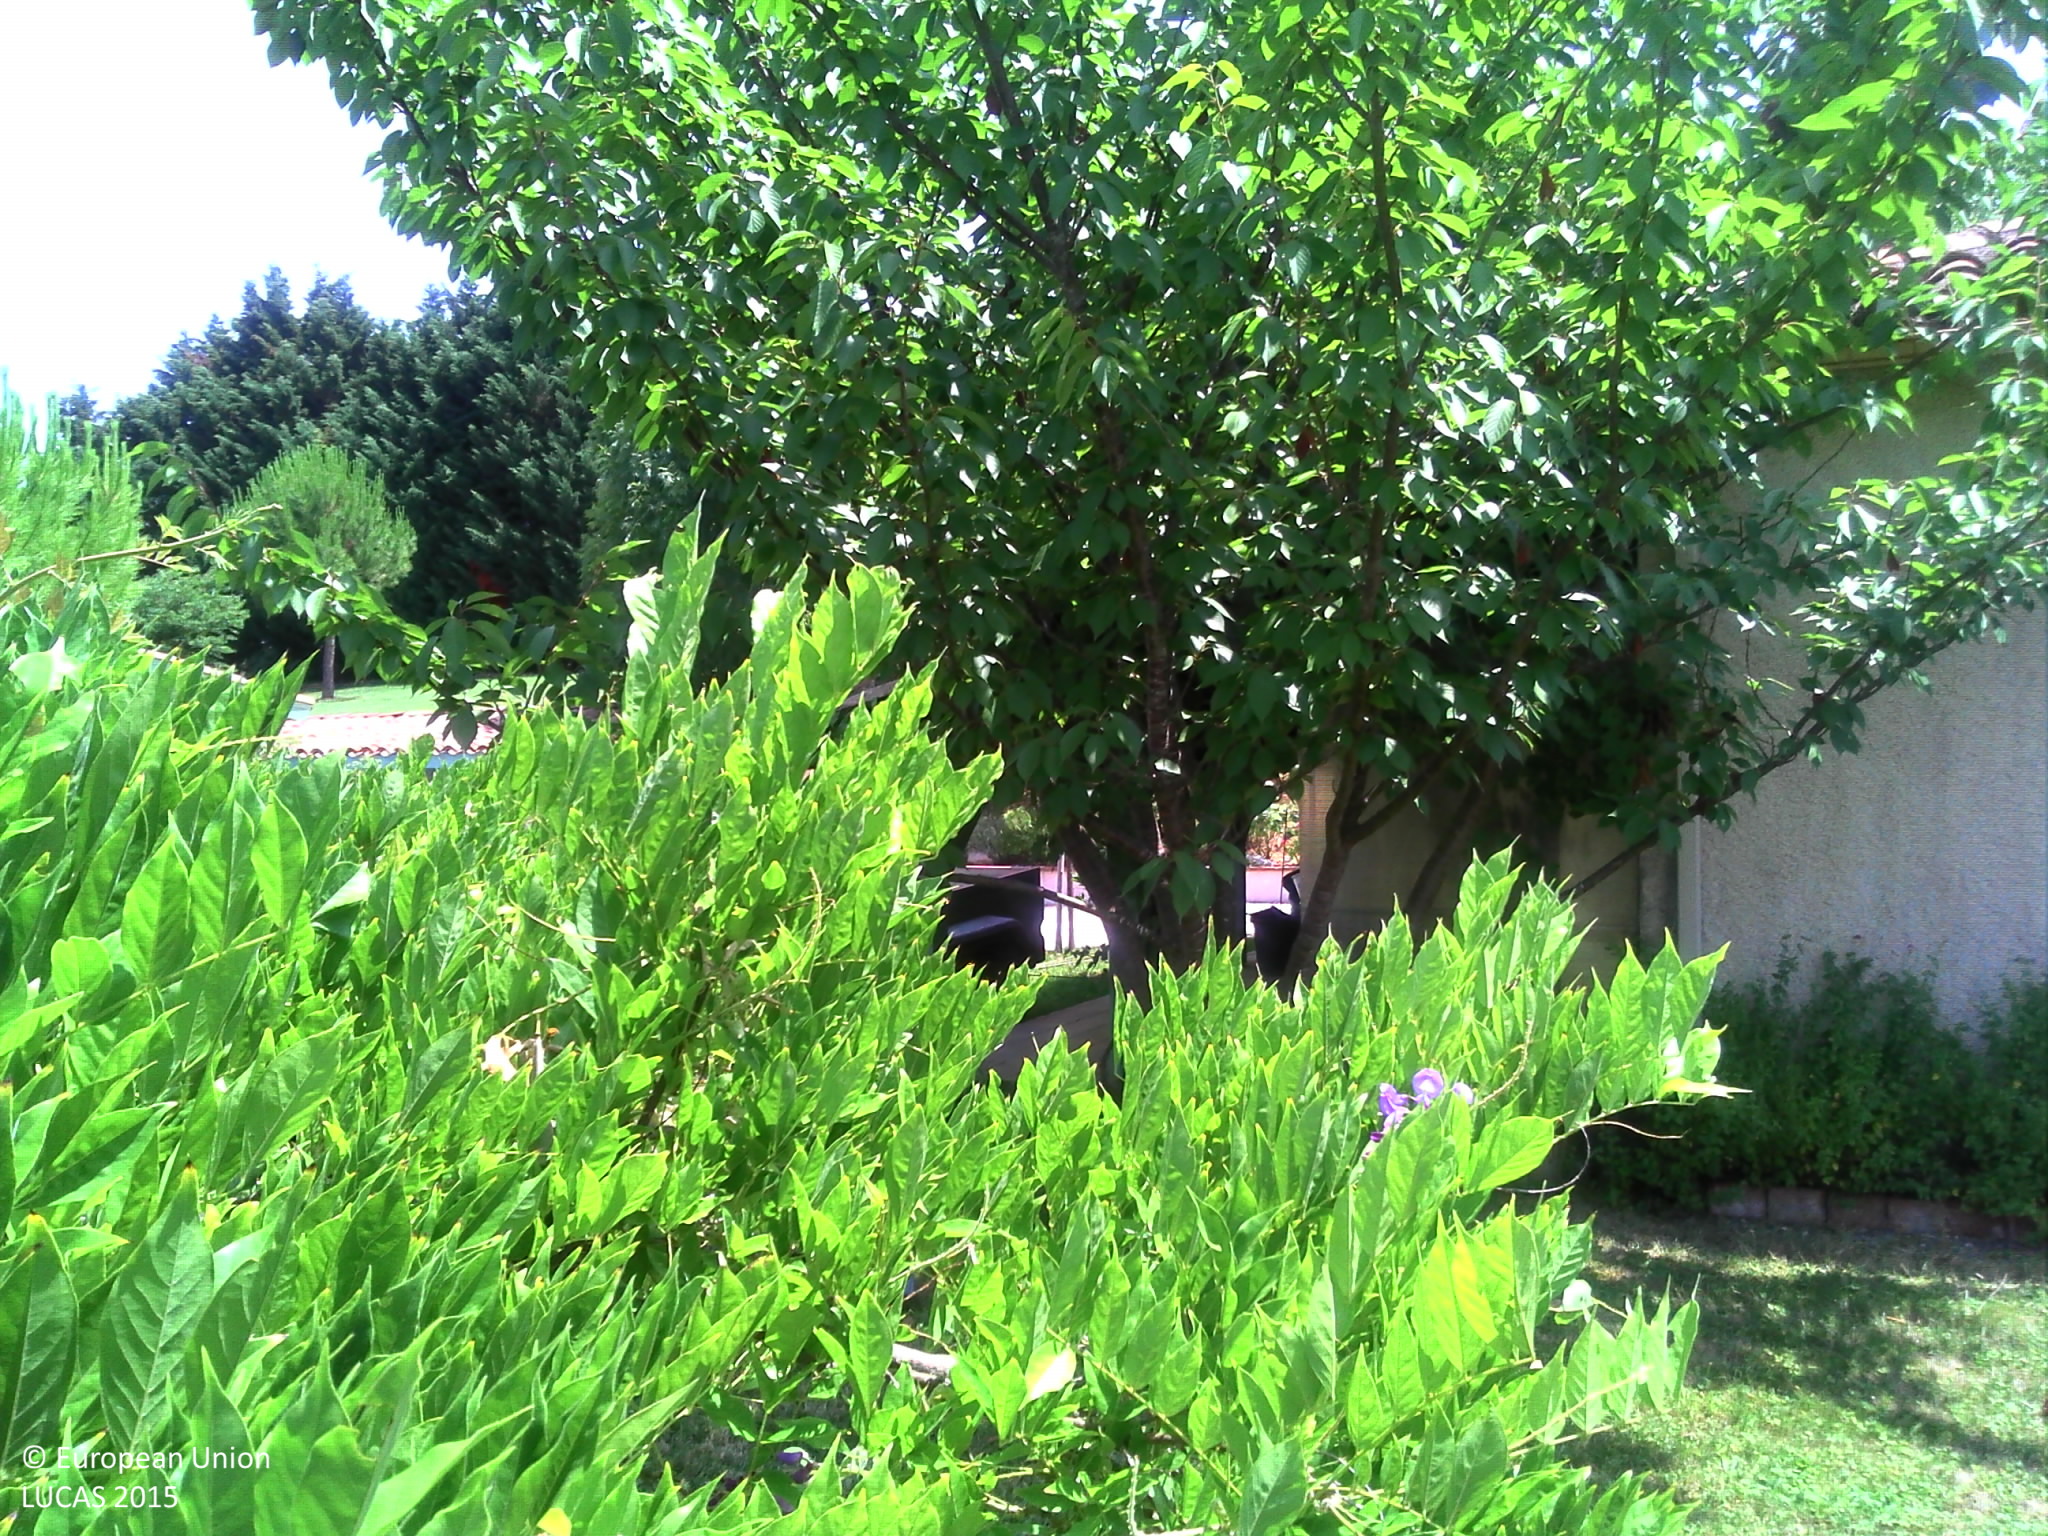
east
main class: Grassland
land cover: Grassland with sparse tree/shrub cover
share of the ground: > 75 %
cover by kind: herbaceous plants 85 %, shrubs 10 %, broadleaved forest trees 5 %
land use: Residential
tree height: < 5 m
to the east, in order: Grassland with sparse tree/shrub cover; Artificial constructions in urban areas; Sunflower; Artificial constructions in urban areas; Spontaneously vegetated surfaces; Electric lines; Spontaneously vegetated surfaces
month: July
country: FR
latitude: 43.4838
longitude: 0.9626
